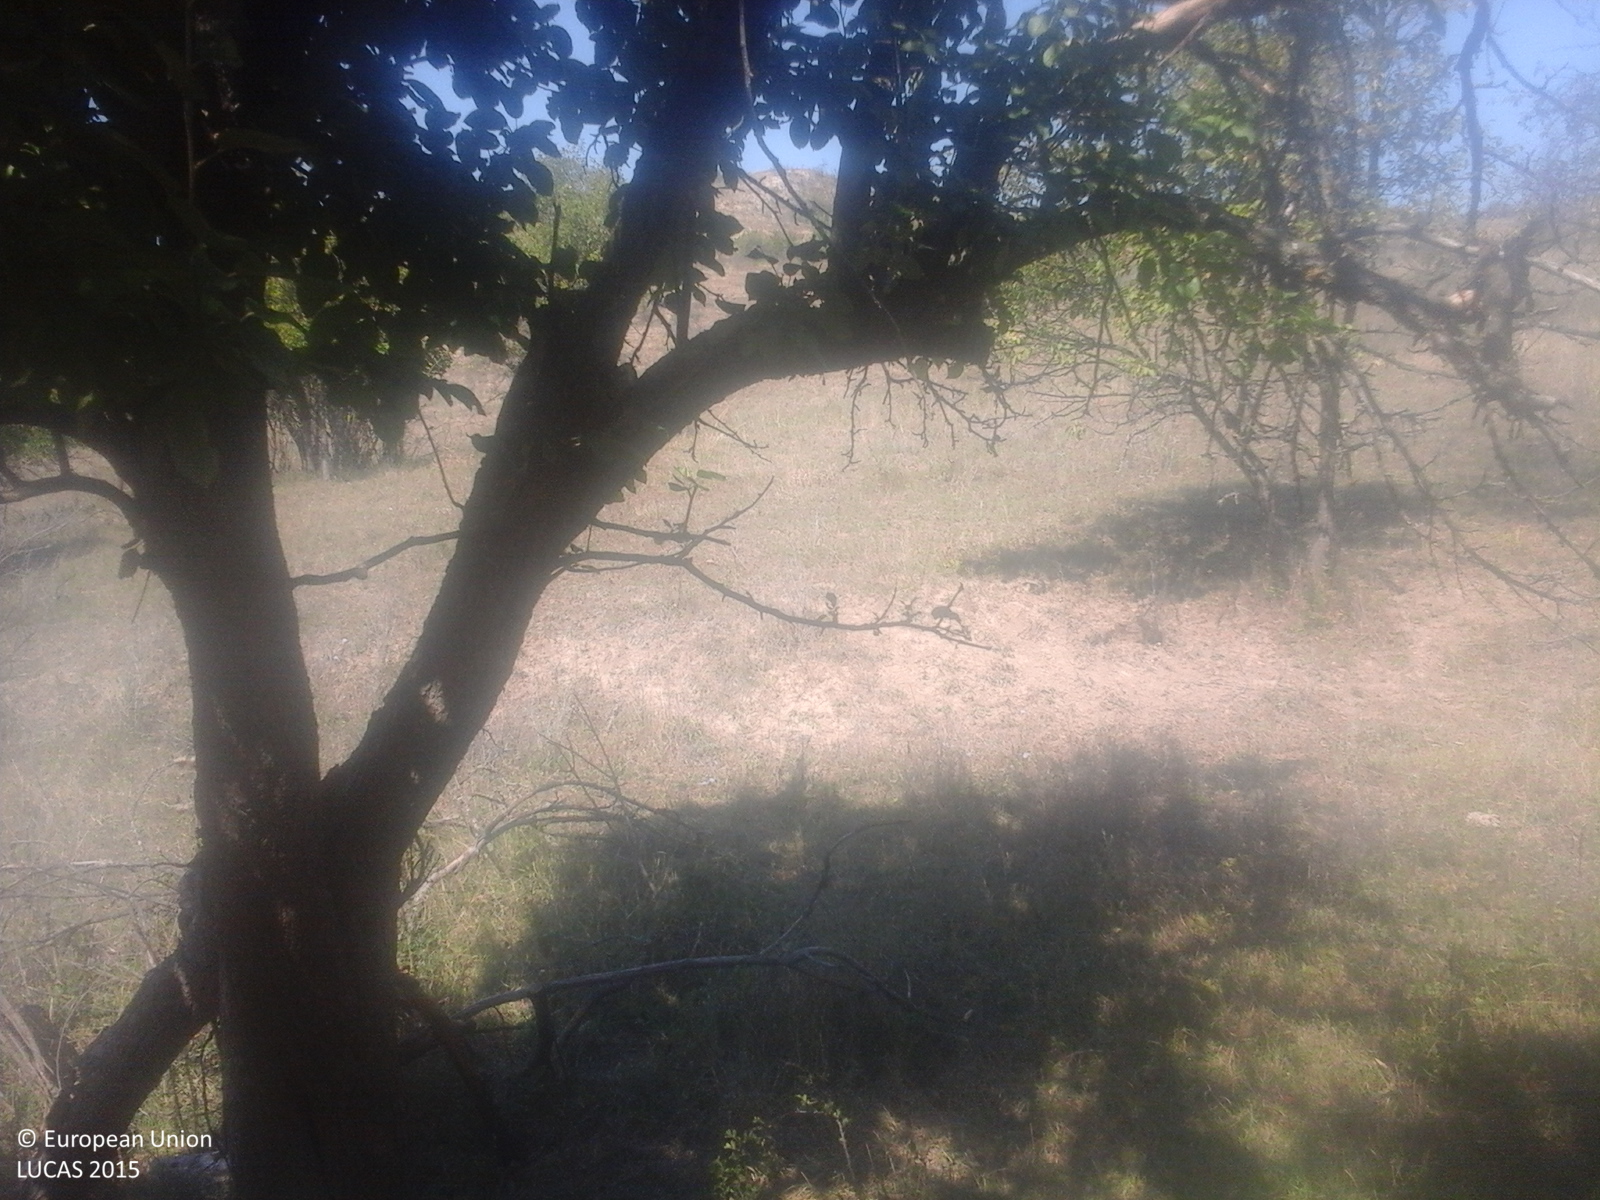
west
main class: Grassland
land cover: Grassland with sparse tree/shrub cover
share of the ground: > 75 %
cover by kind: herbaceous plants 85 %, shrubs 10 %, broadleaved forest trees 5 %
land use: Agriculture (excluding fallow land and kitchen gardens)
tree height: < 5 m
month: September
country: RO
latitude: 46.8063
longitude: 24.4631
